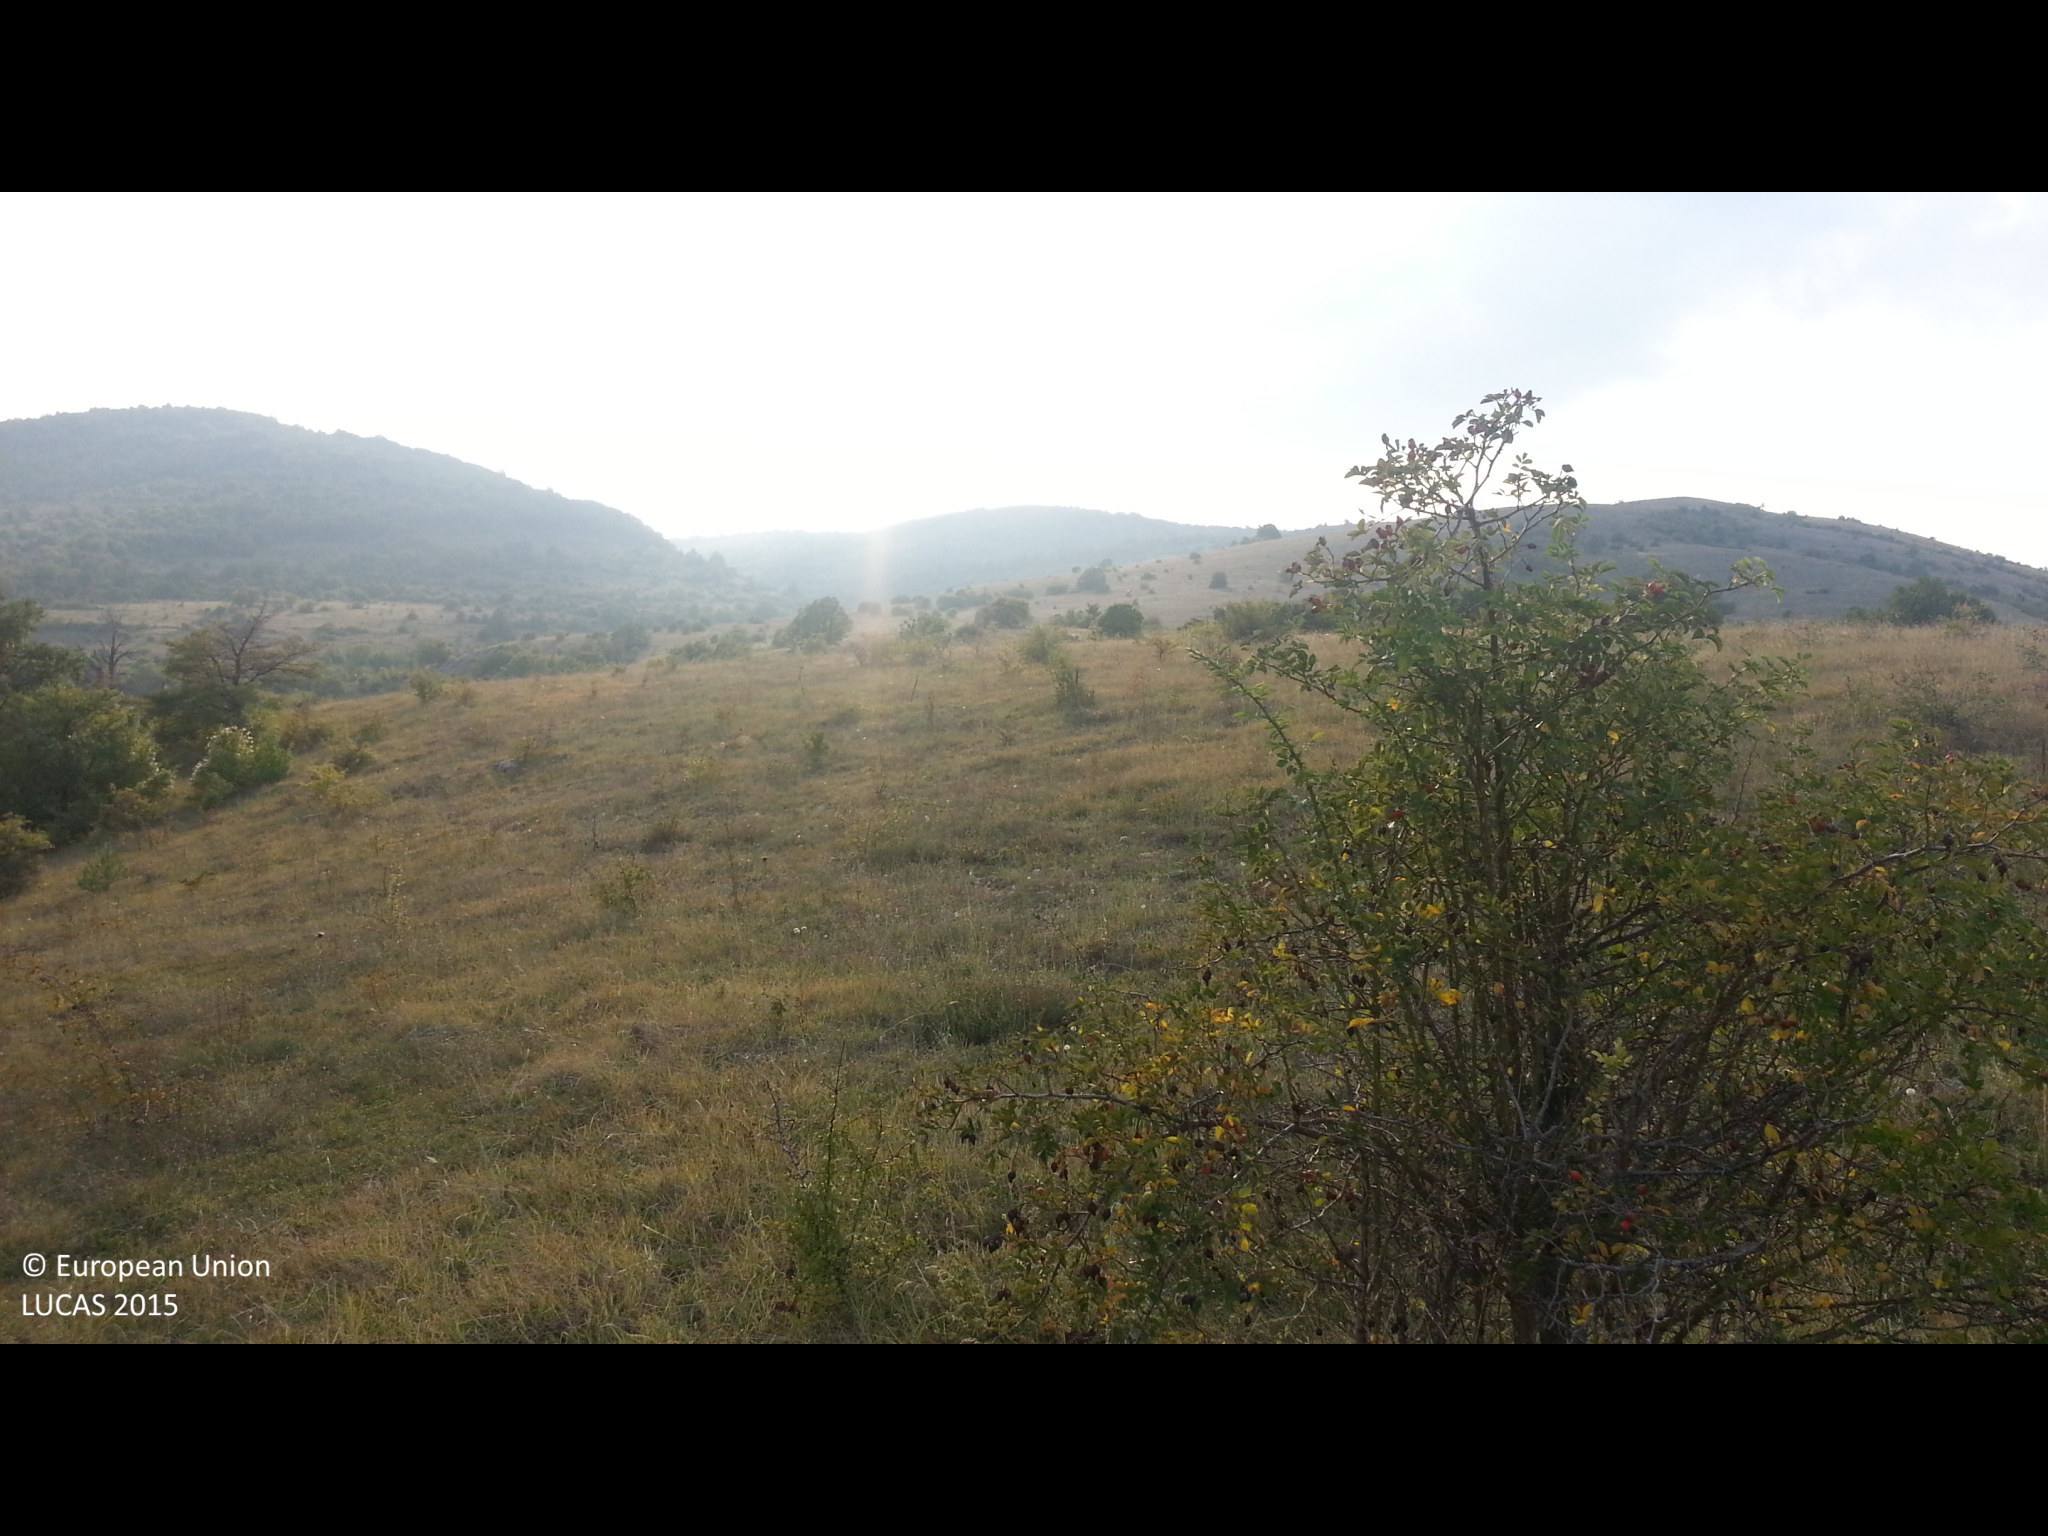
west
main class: Grassland
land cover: Grassland with sparse tree/shrub cover
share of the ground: > 75 %
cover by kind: herbaceous plants 90 %, broadleaved forest trees 5 %, shrubs 5 %
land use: Agriculture (excluding fallow land and kitchen gardens)
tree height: < 5 m
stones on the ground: < 10 %
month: September
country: BG
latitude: 42.5487
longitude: 23.0966
